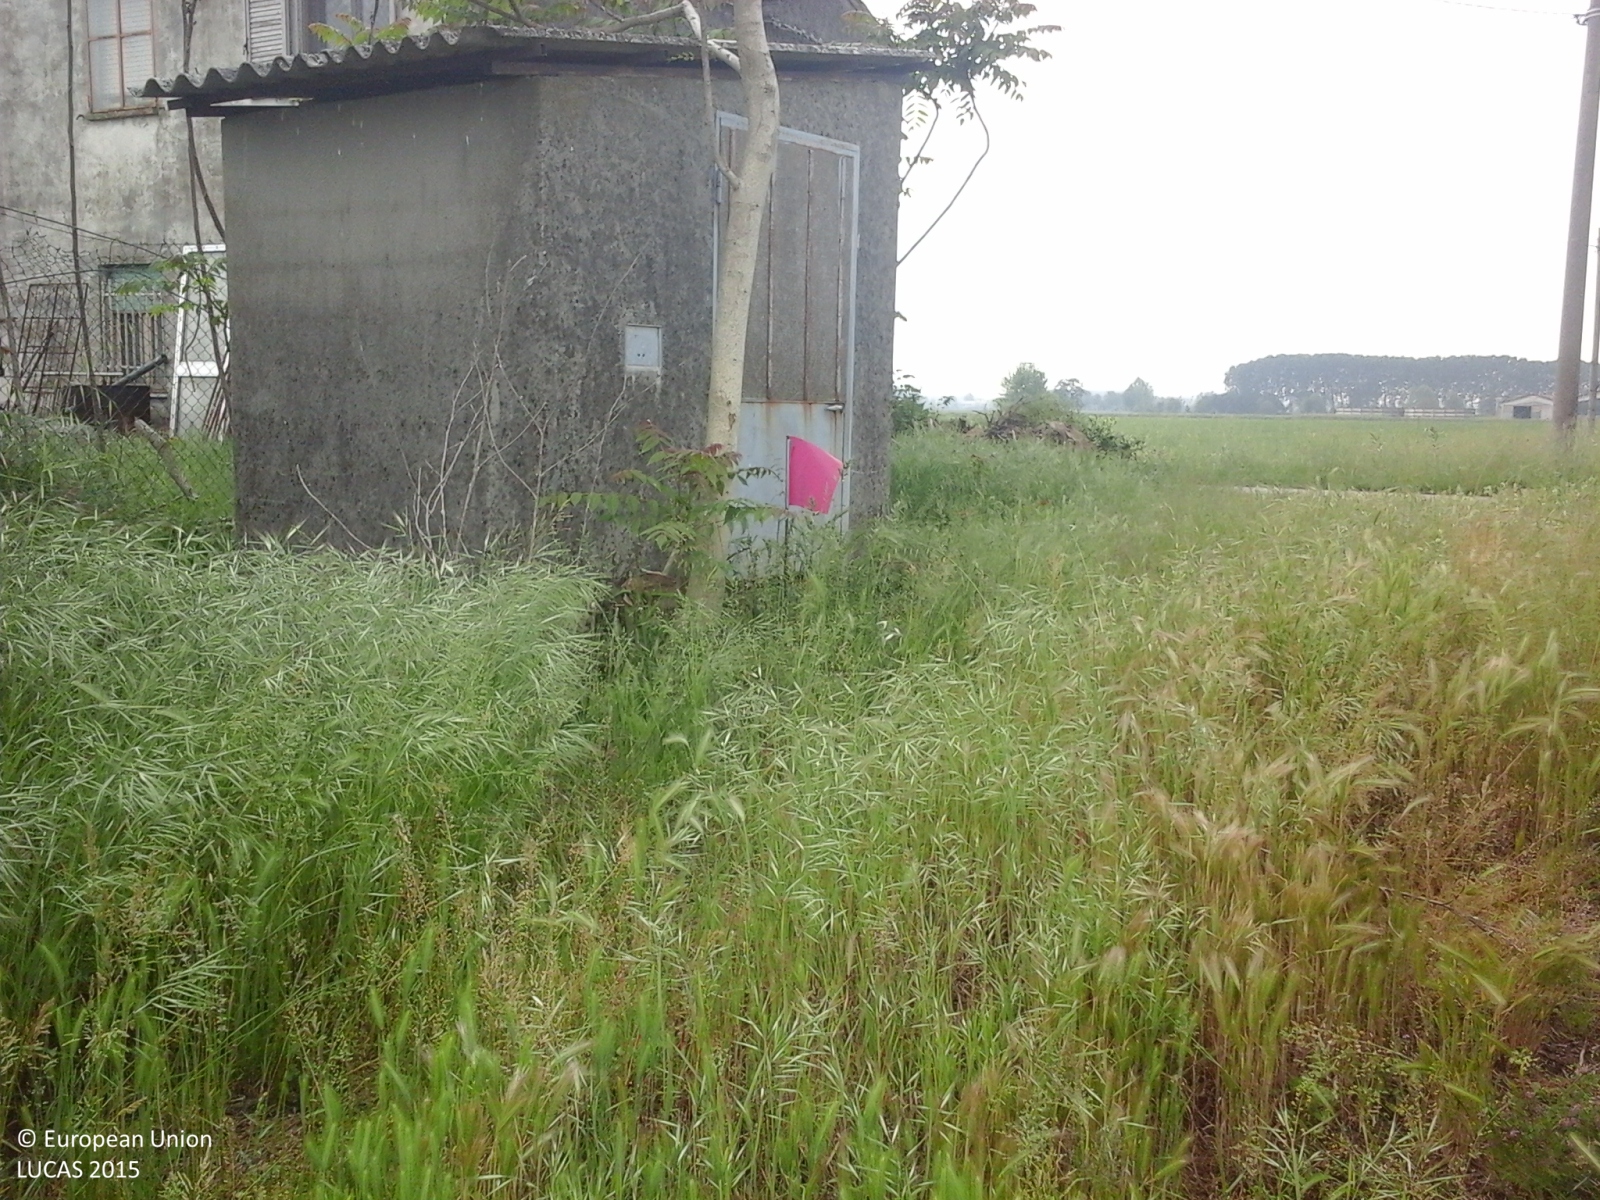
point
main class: Grassland
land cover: Grassland with sparse tree/shrub cover
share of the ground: > 75 %
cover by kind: herbaceous plants 95 %, broadleaved forest trees 5 %
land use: Agriculture (excluding fallow land and kitchen gardens)
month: May
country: IT
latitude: 45.2337
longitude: 10.2670
